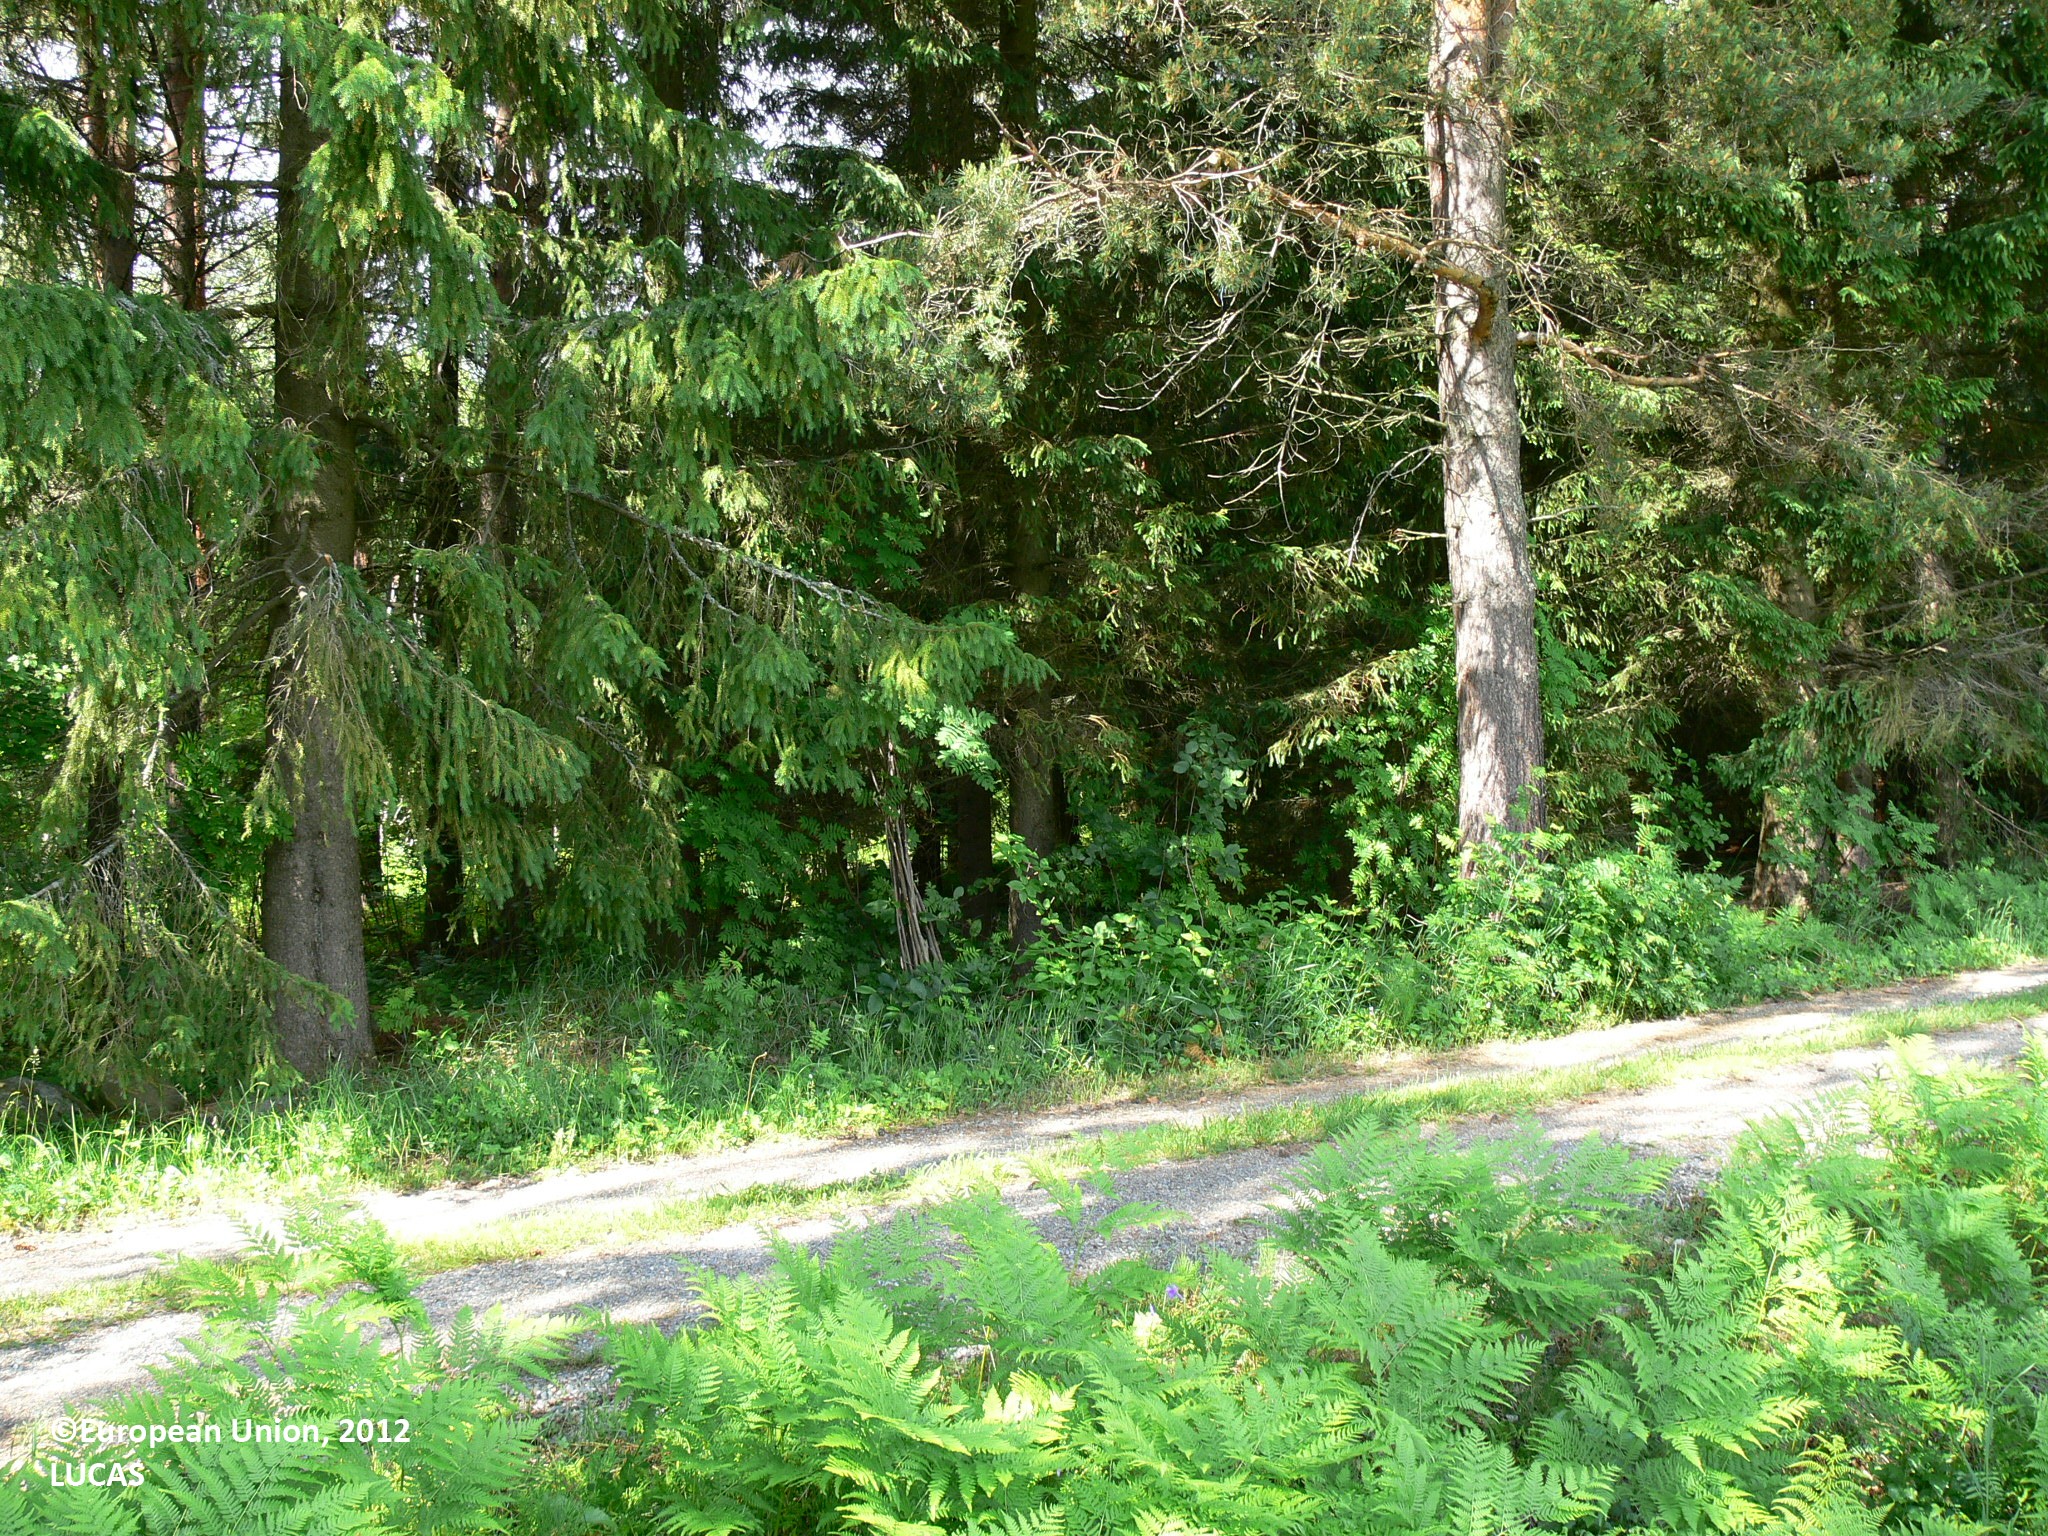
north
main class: Cropland
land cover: Temporary grasslands
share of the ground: > 75 %
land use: Agriculture (excluding fallow land and kitchen gardens)
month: June
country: FI
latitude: 62.6567
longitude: 29.2550
